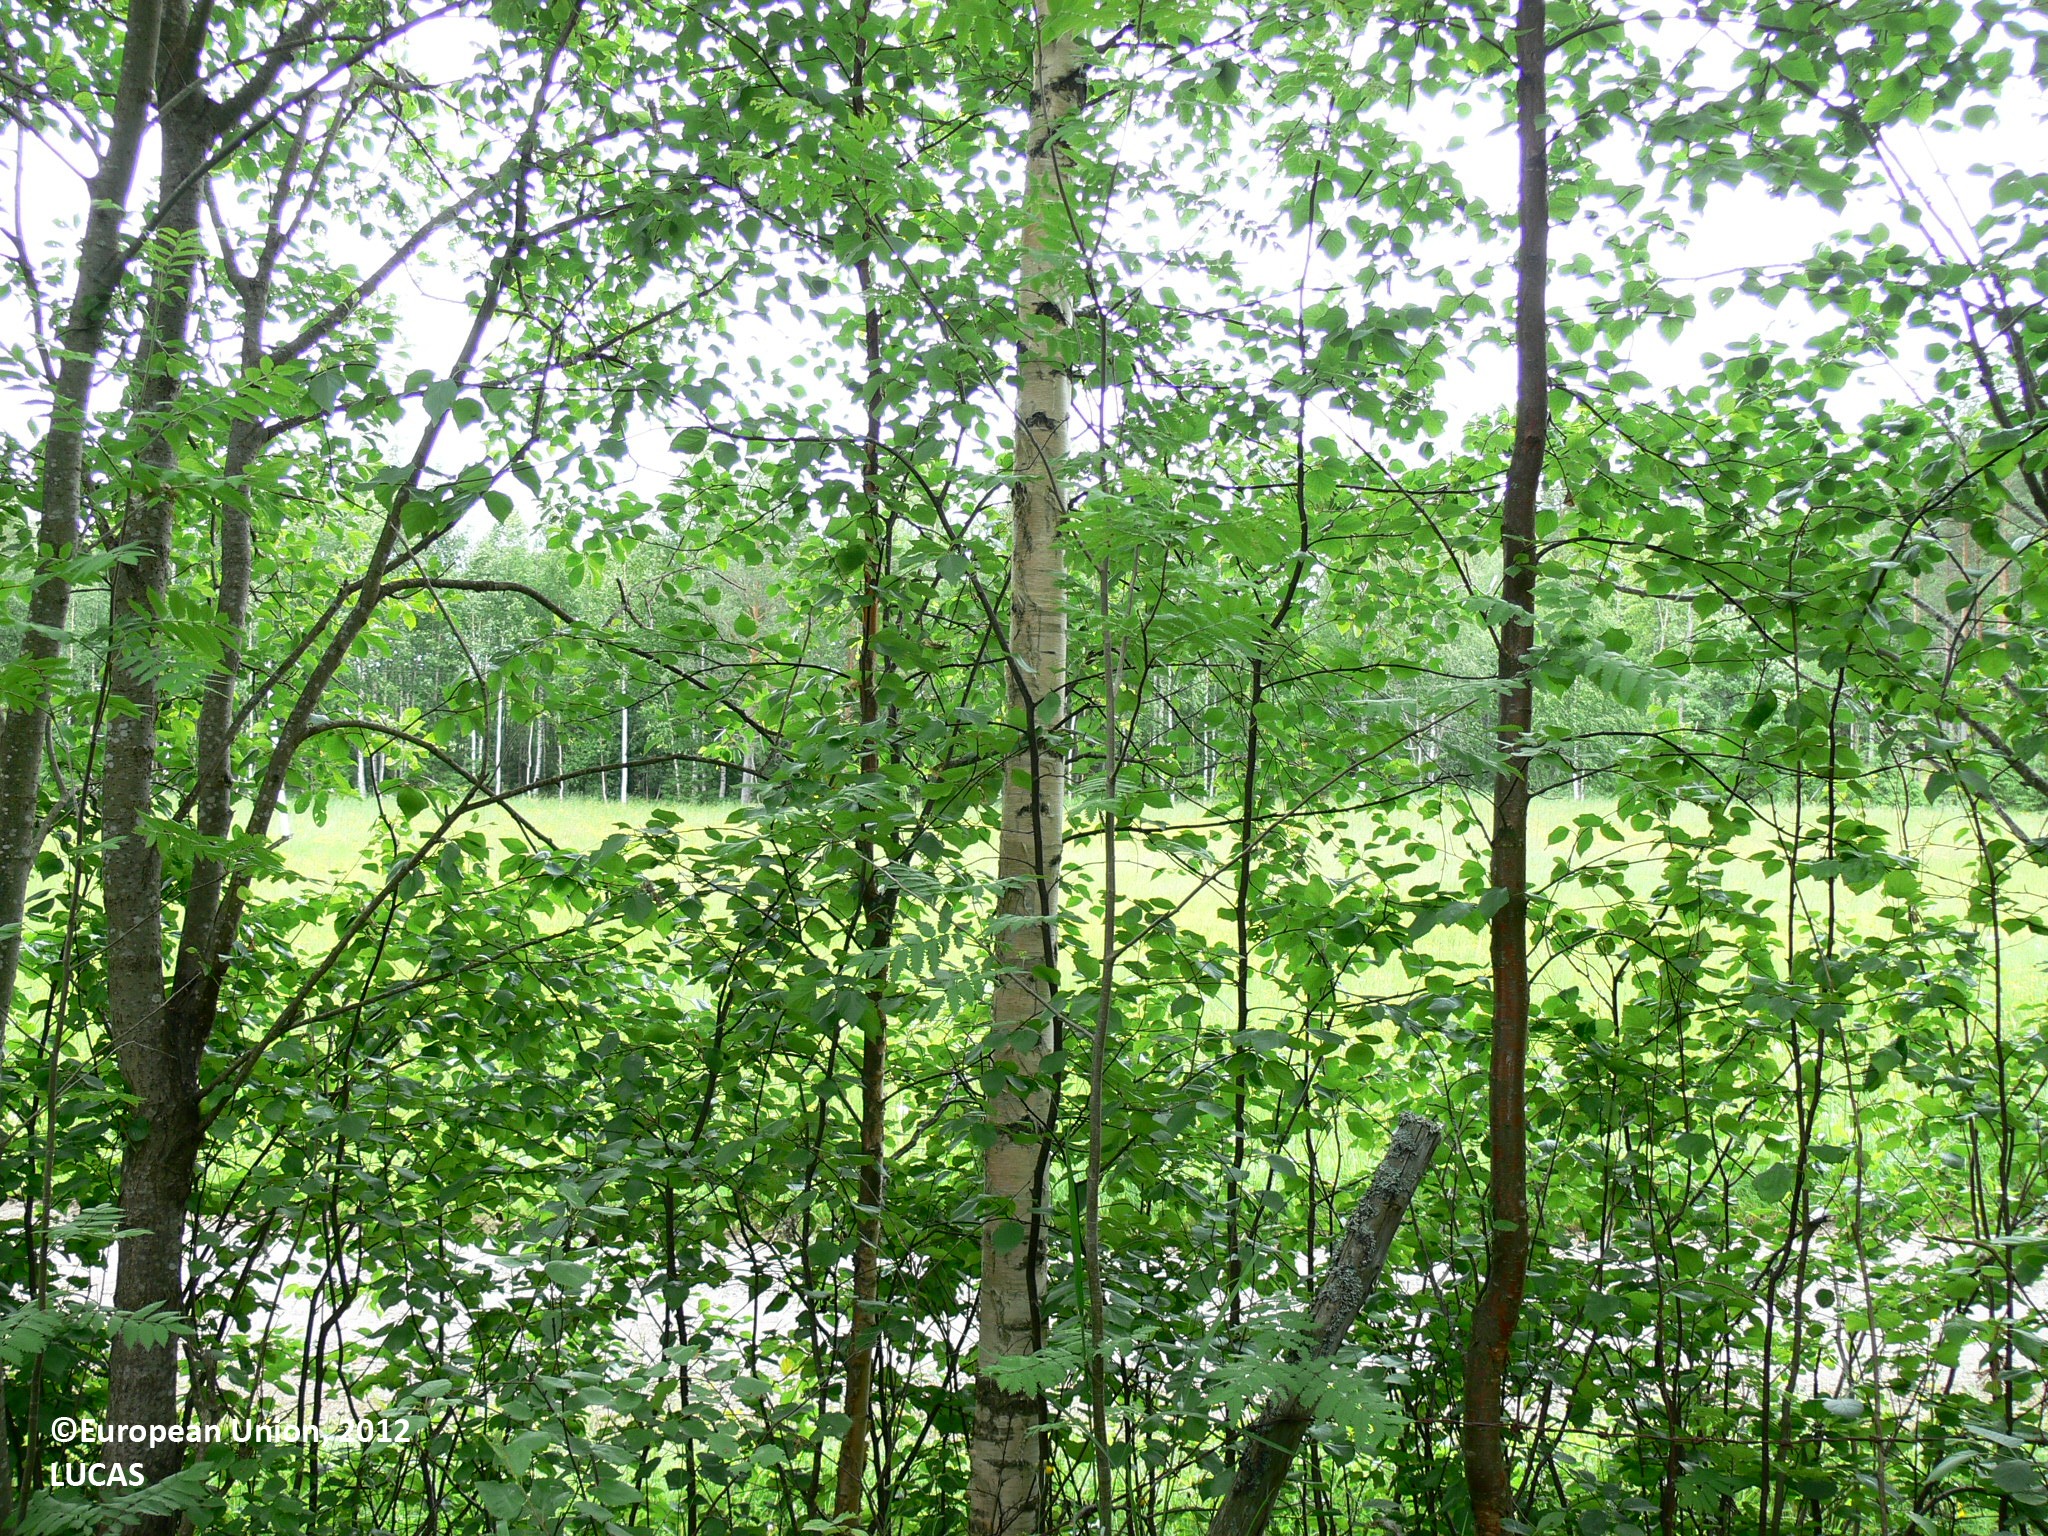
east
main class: Woodland
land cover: Pine dominated mixed woodland
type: boreal forest
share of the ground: > 75 %
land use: Forestry
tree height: > 5 m
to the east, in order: Pine dominated mixed woodland; Ditches and canals; Grass margins; Paved roads, cycling and walking lanes; Grass margins; Spontaneously vegetated surfaces; Electric lines; Spontaneously vegetated surfaces; Ditches and canals; Spruce dominated mixed woodland; Ditches and canals; Oats
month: June
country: FI
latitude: 62.7773
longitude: 29.3344
